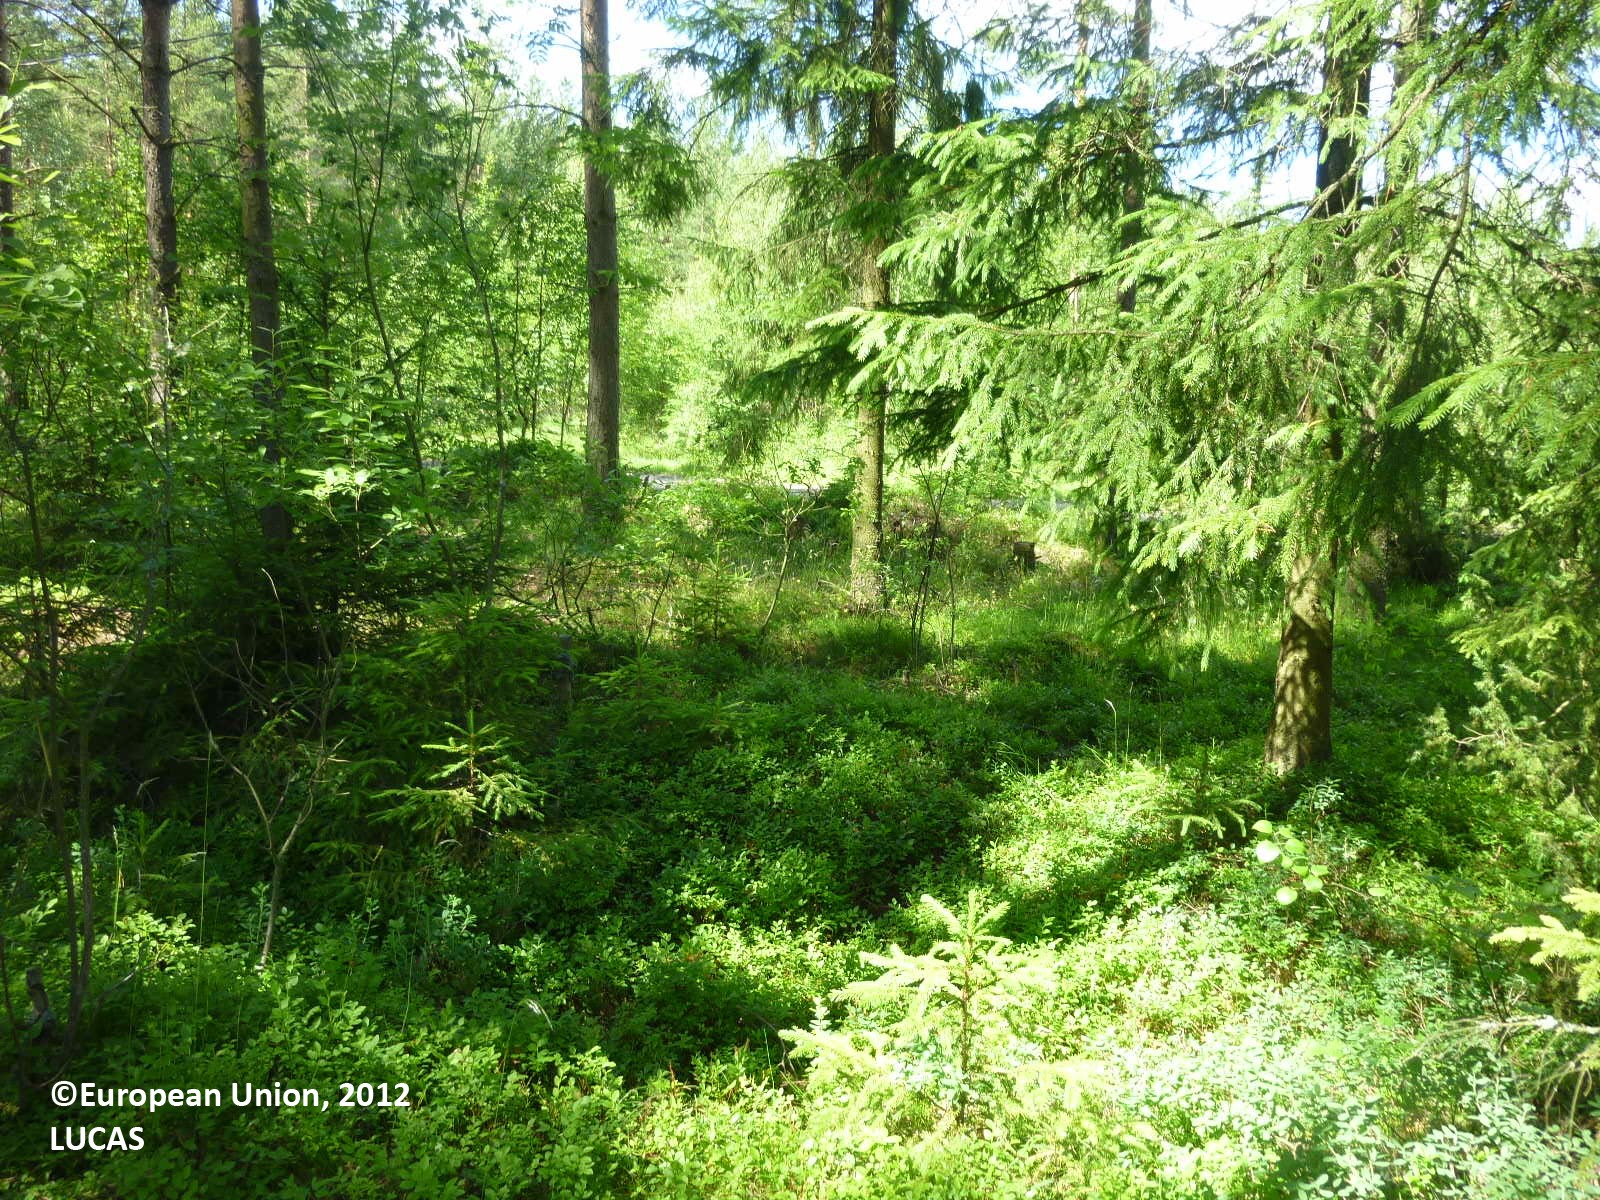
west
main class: Woodland
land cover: Other coniferous woodland
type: boreal forest
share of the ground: > 75 %
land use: Forestry
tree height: > 5 m
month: July
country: FI
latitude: 61.3533
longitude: 22.1199
